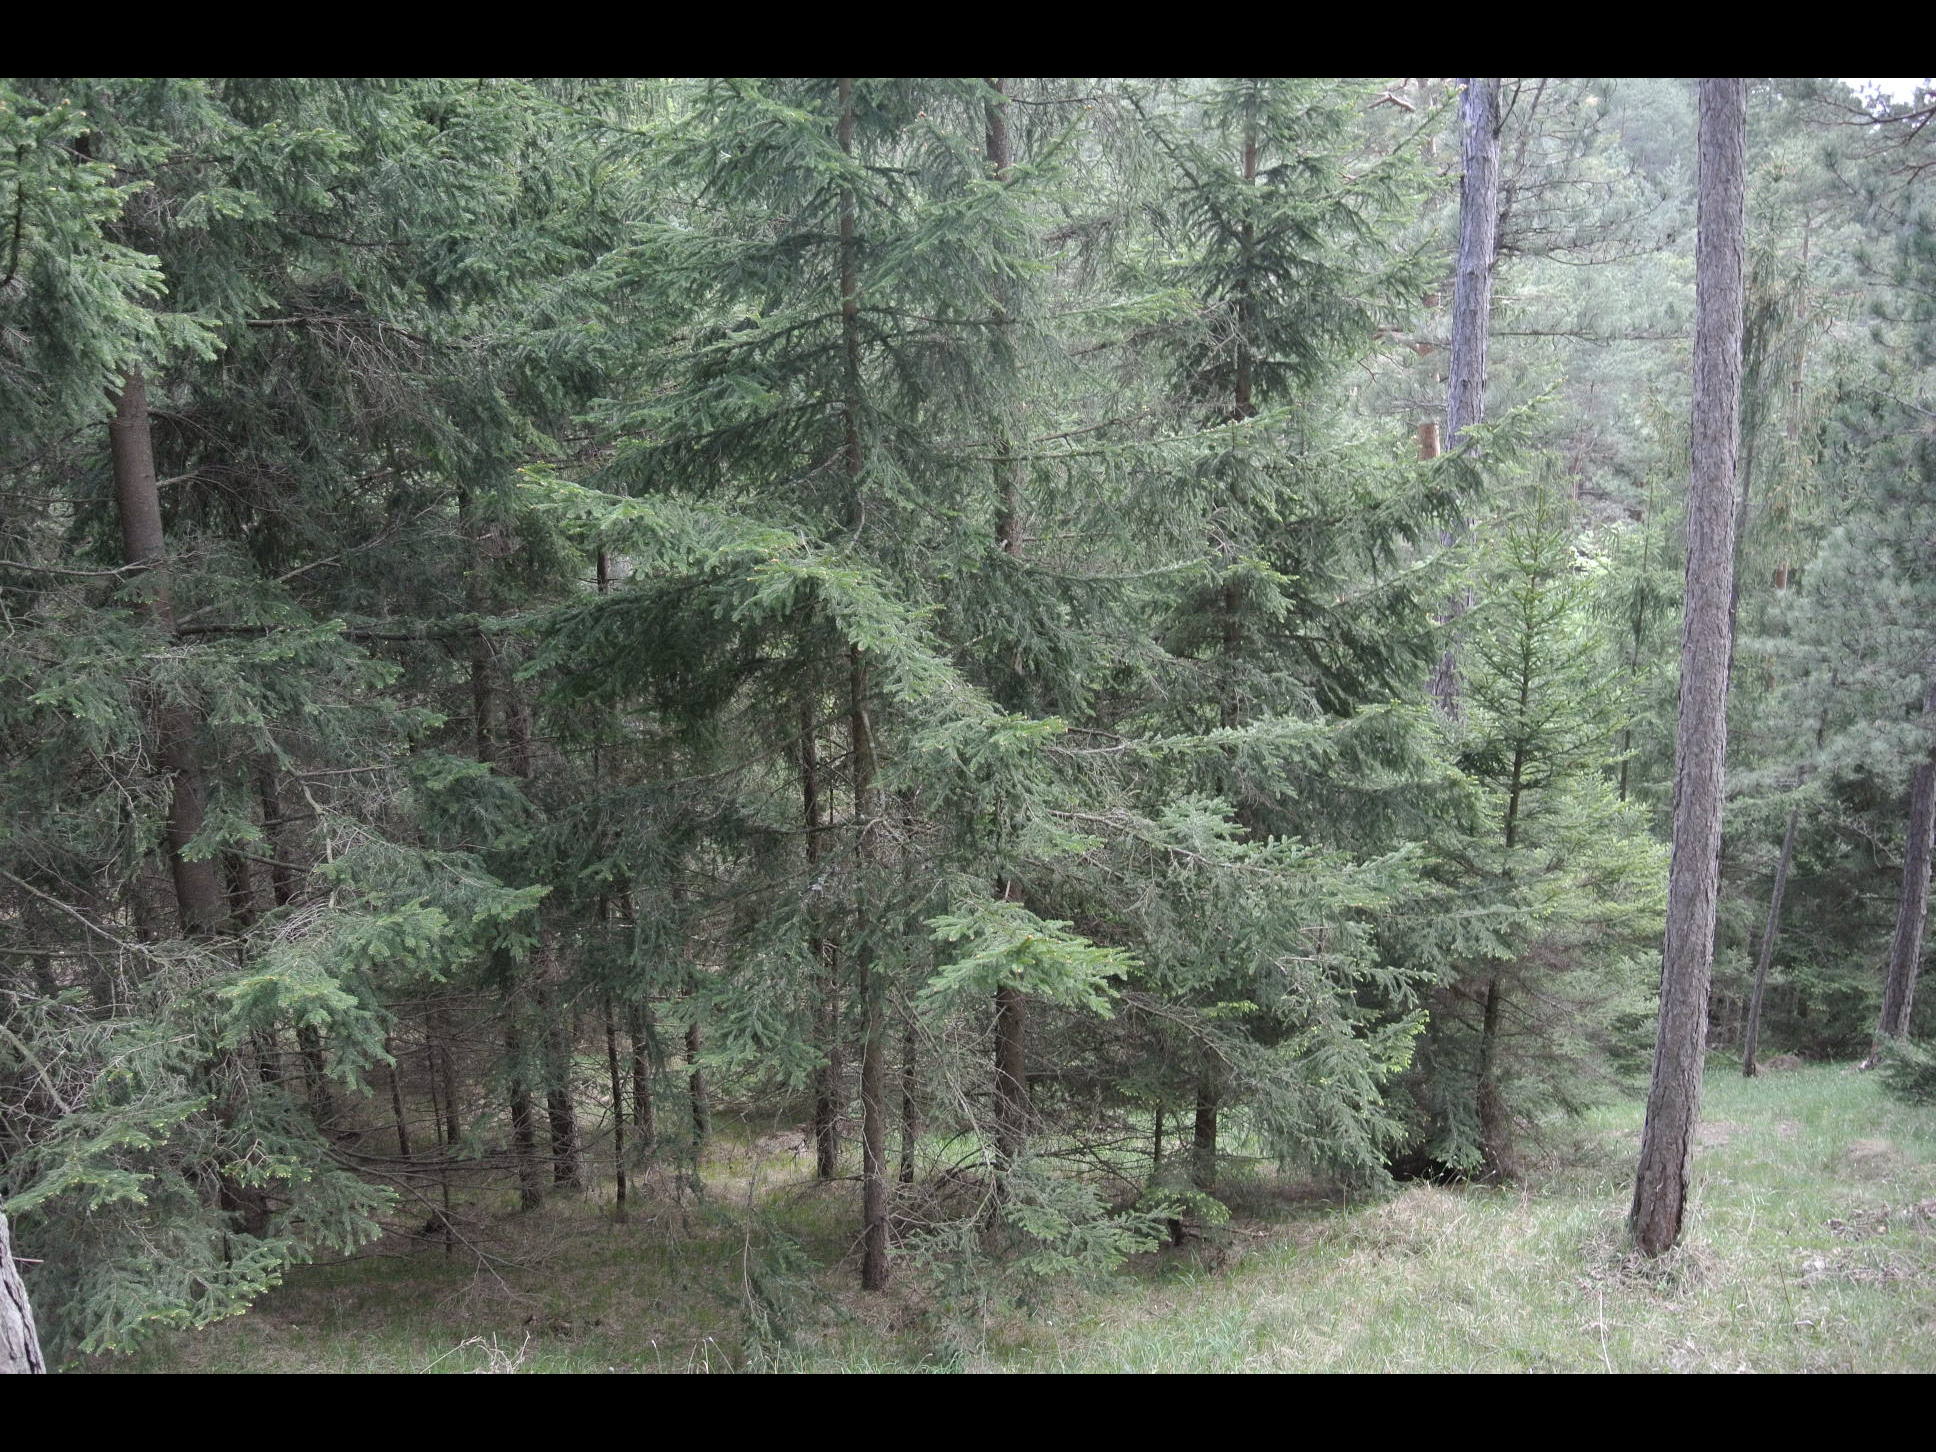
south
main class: Woodland
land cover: Pine dominated mixed woodland
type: alpine coniferous forest
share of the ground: > 75 %
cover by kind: coniferous forest trees 70 %, broadleaved forest trees 25 %, herbaceous plants 5 %
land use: Forestry
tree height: > 5 m
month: May
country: AT
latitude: 47.9152
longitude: 16.0111
